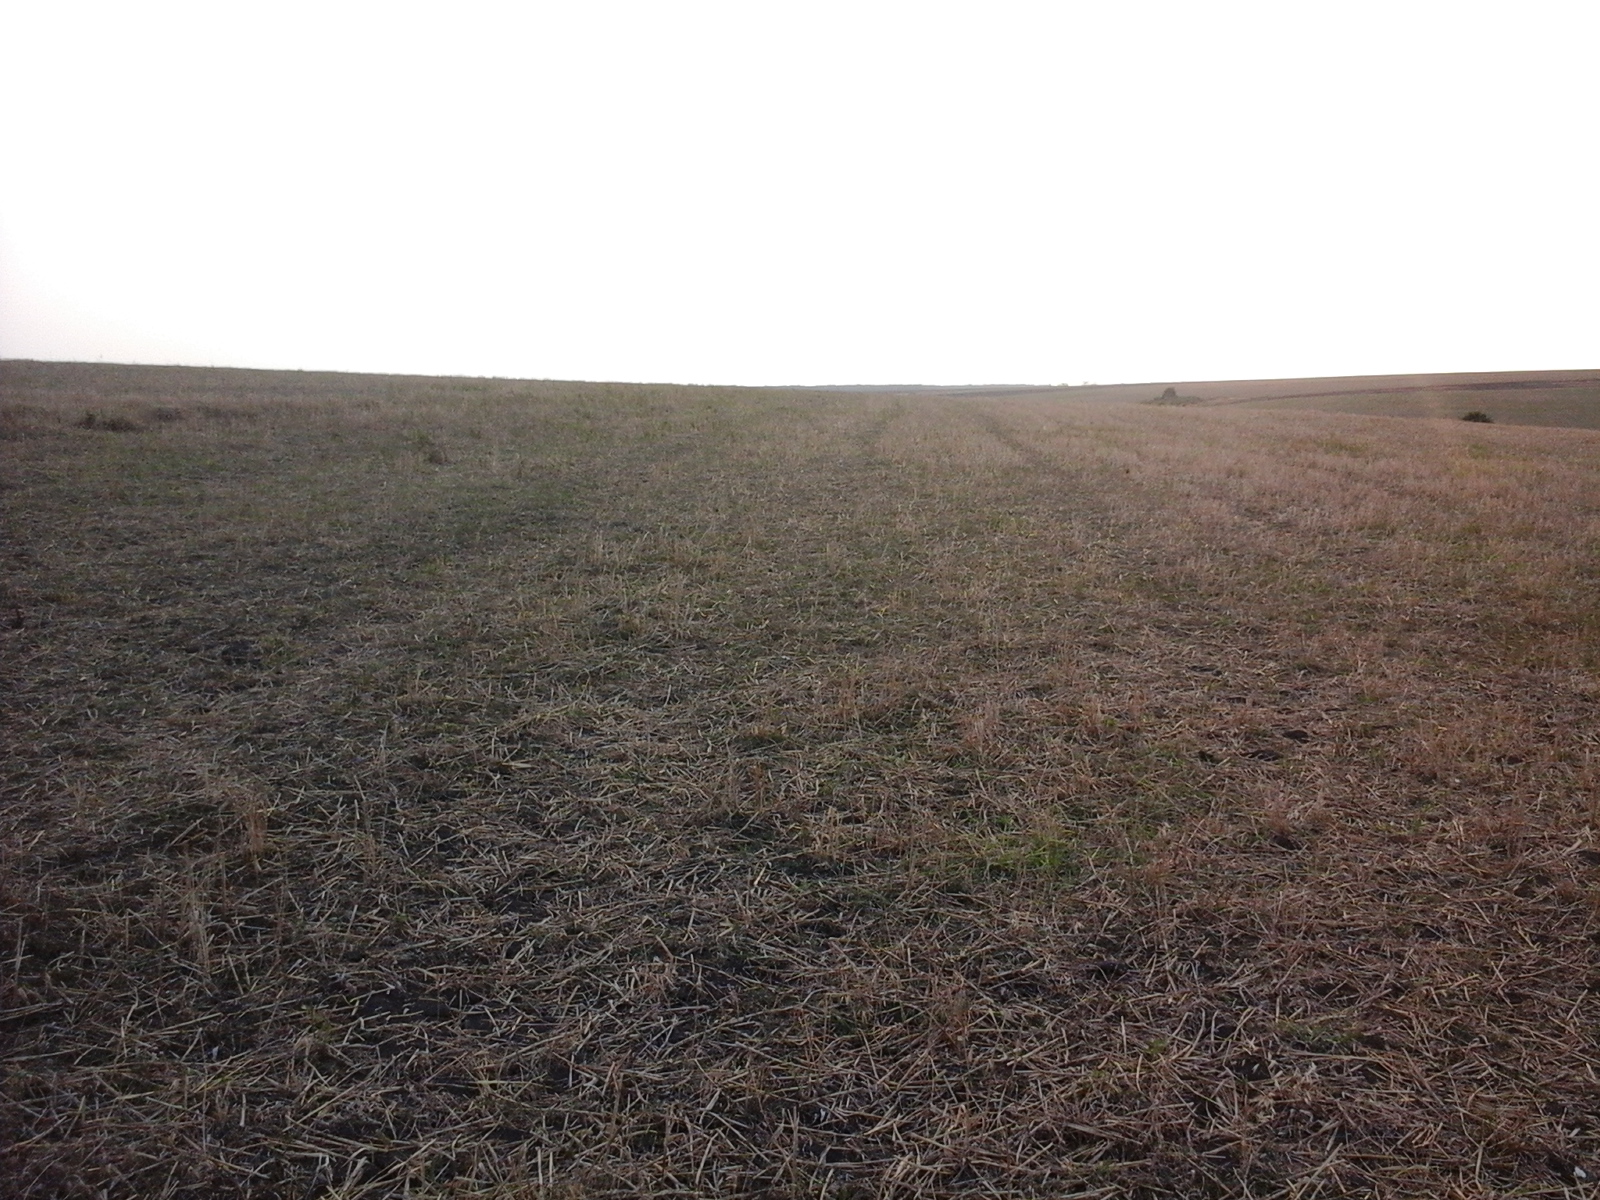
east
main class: Cropland
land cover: Oats
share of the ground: 25 - 50 %
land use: Agriculture (excluding fallow land and kitchen gardens)
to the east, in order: Oats; Grassland with sparse tree/shrub cover; Tracks; Grassland without tree/shrub cover
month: August
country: RO
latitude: 44.4622
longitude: 23.8213
